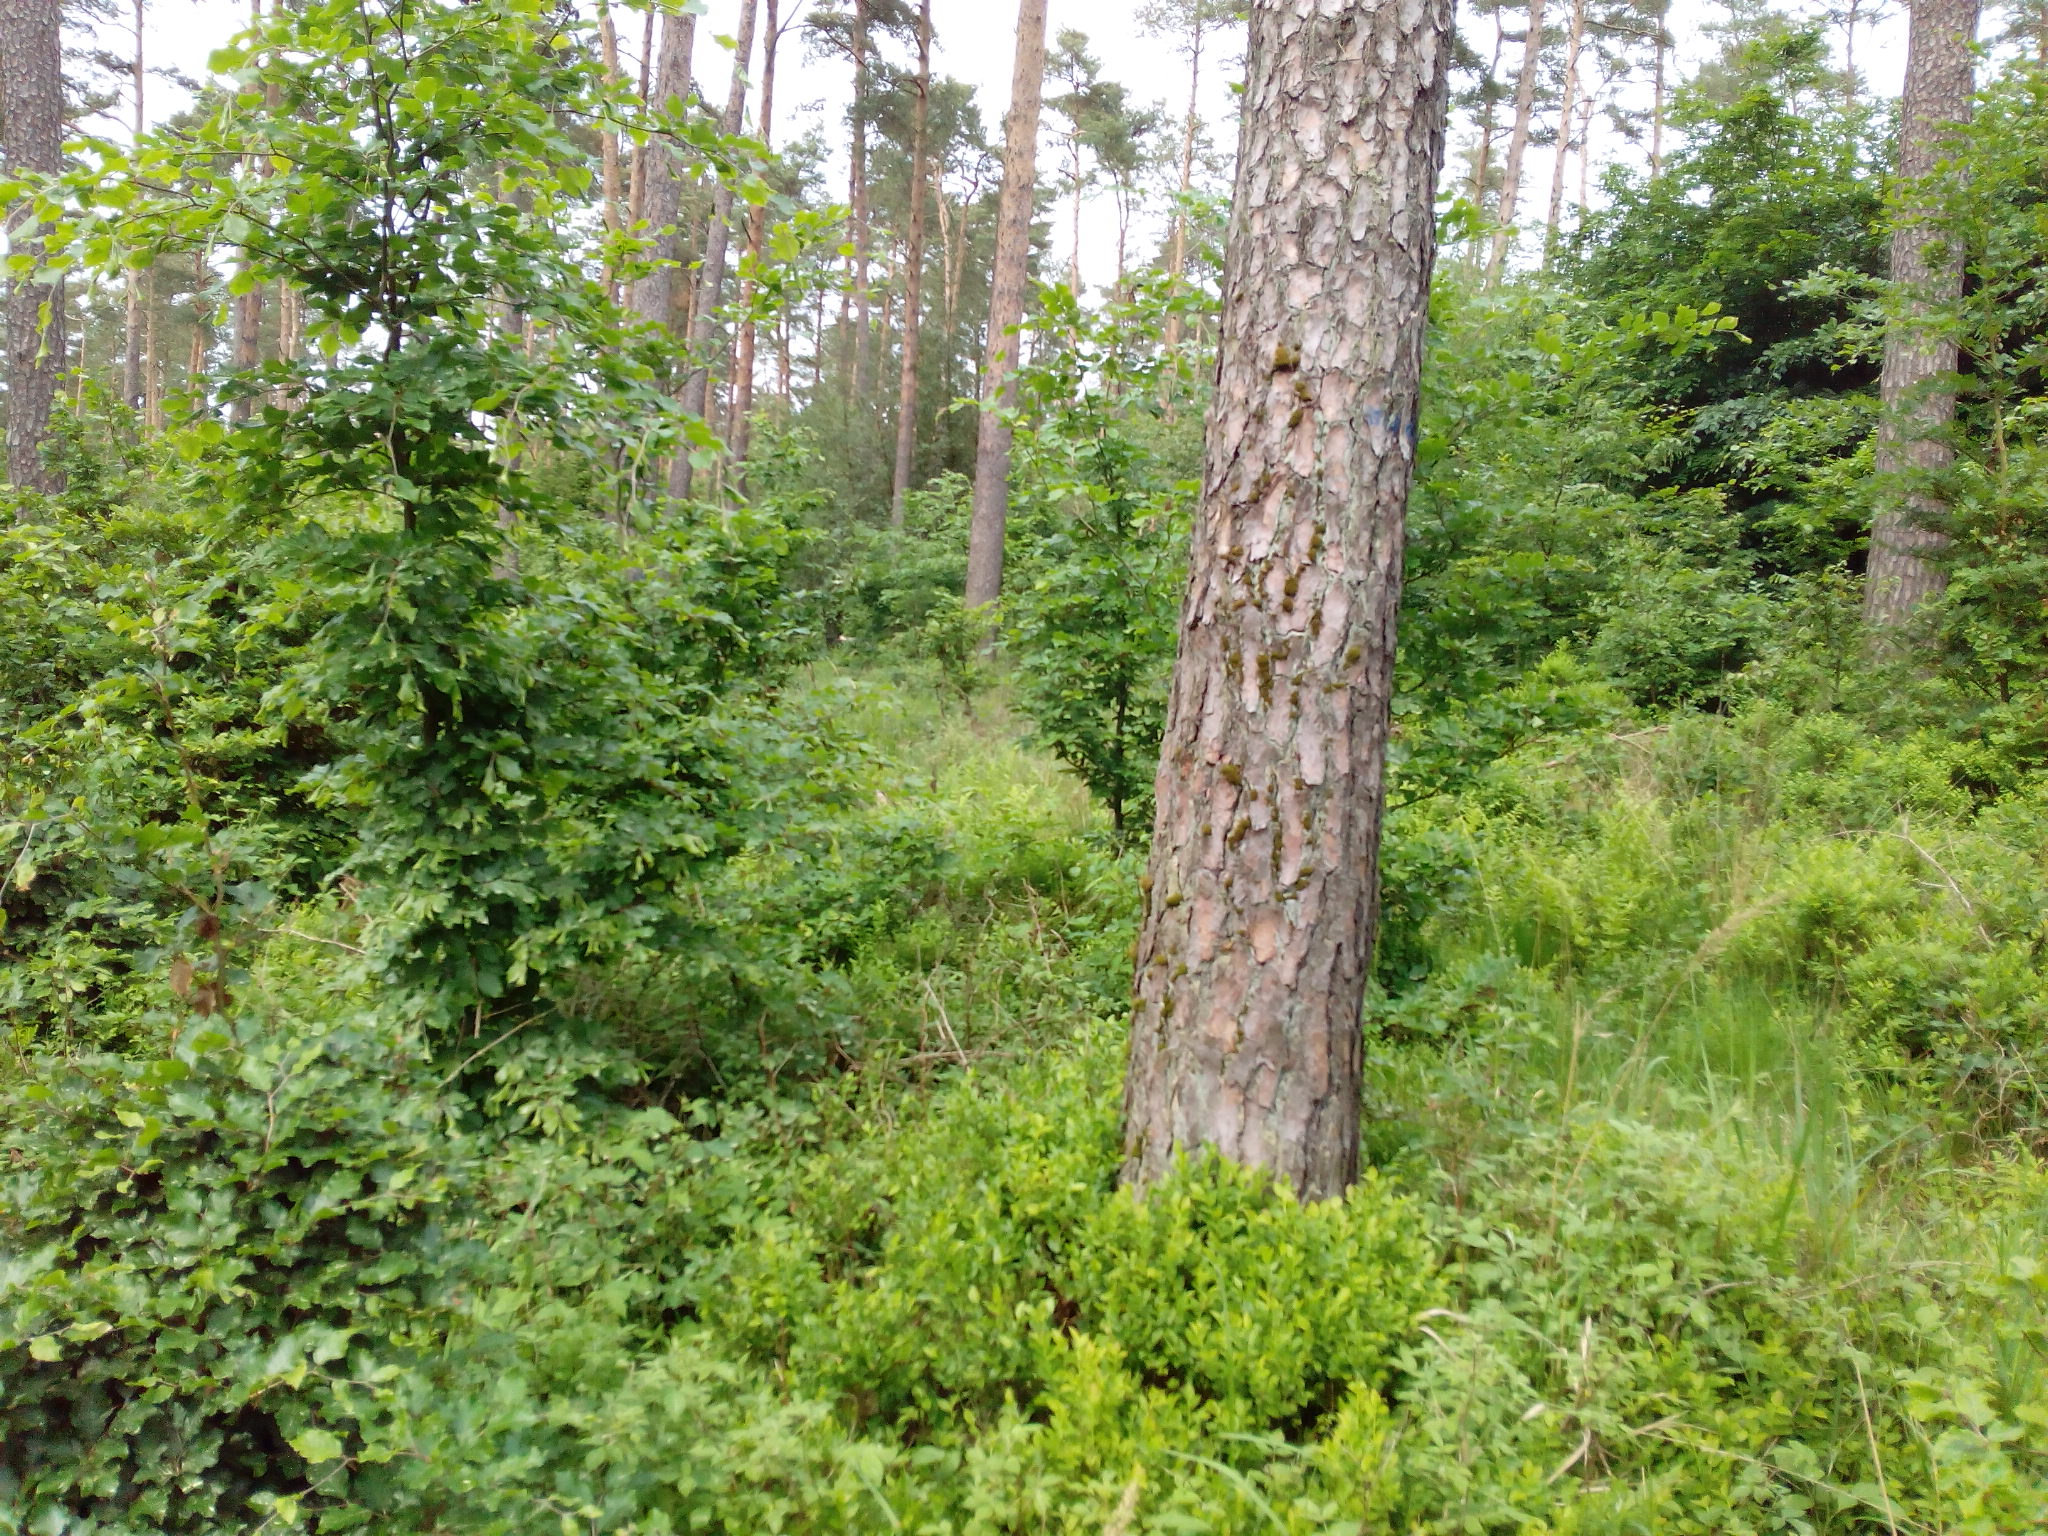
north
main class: Woodland
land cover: Pine dominated mixed woodland
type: hemiboreal forest and nemoral coniferous forest and mixed broadleaved-coniferous forest
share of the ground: > 75 %
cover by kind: coniferous forest trees 50 %, broadleaved forest trees 20 %, shrubs 20 %, herbaceous plants 10 %
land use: Forestry
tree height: > 5 m
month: June
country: DE
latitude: 52.6111
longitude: 9.9262
